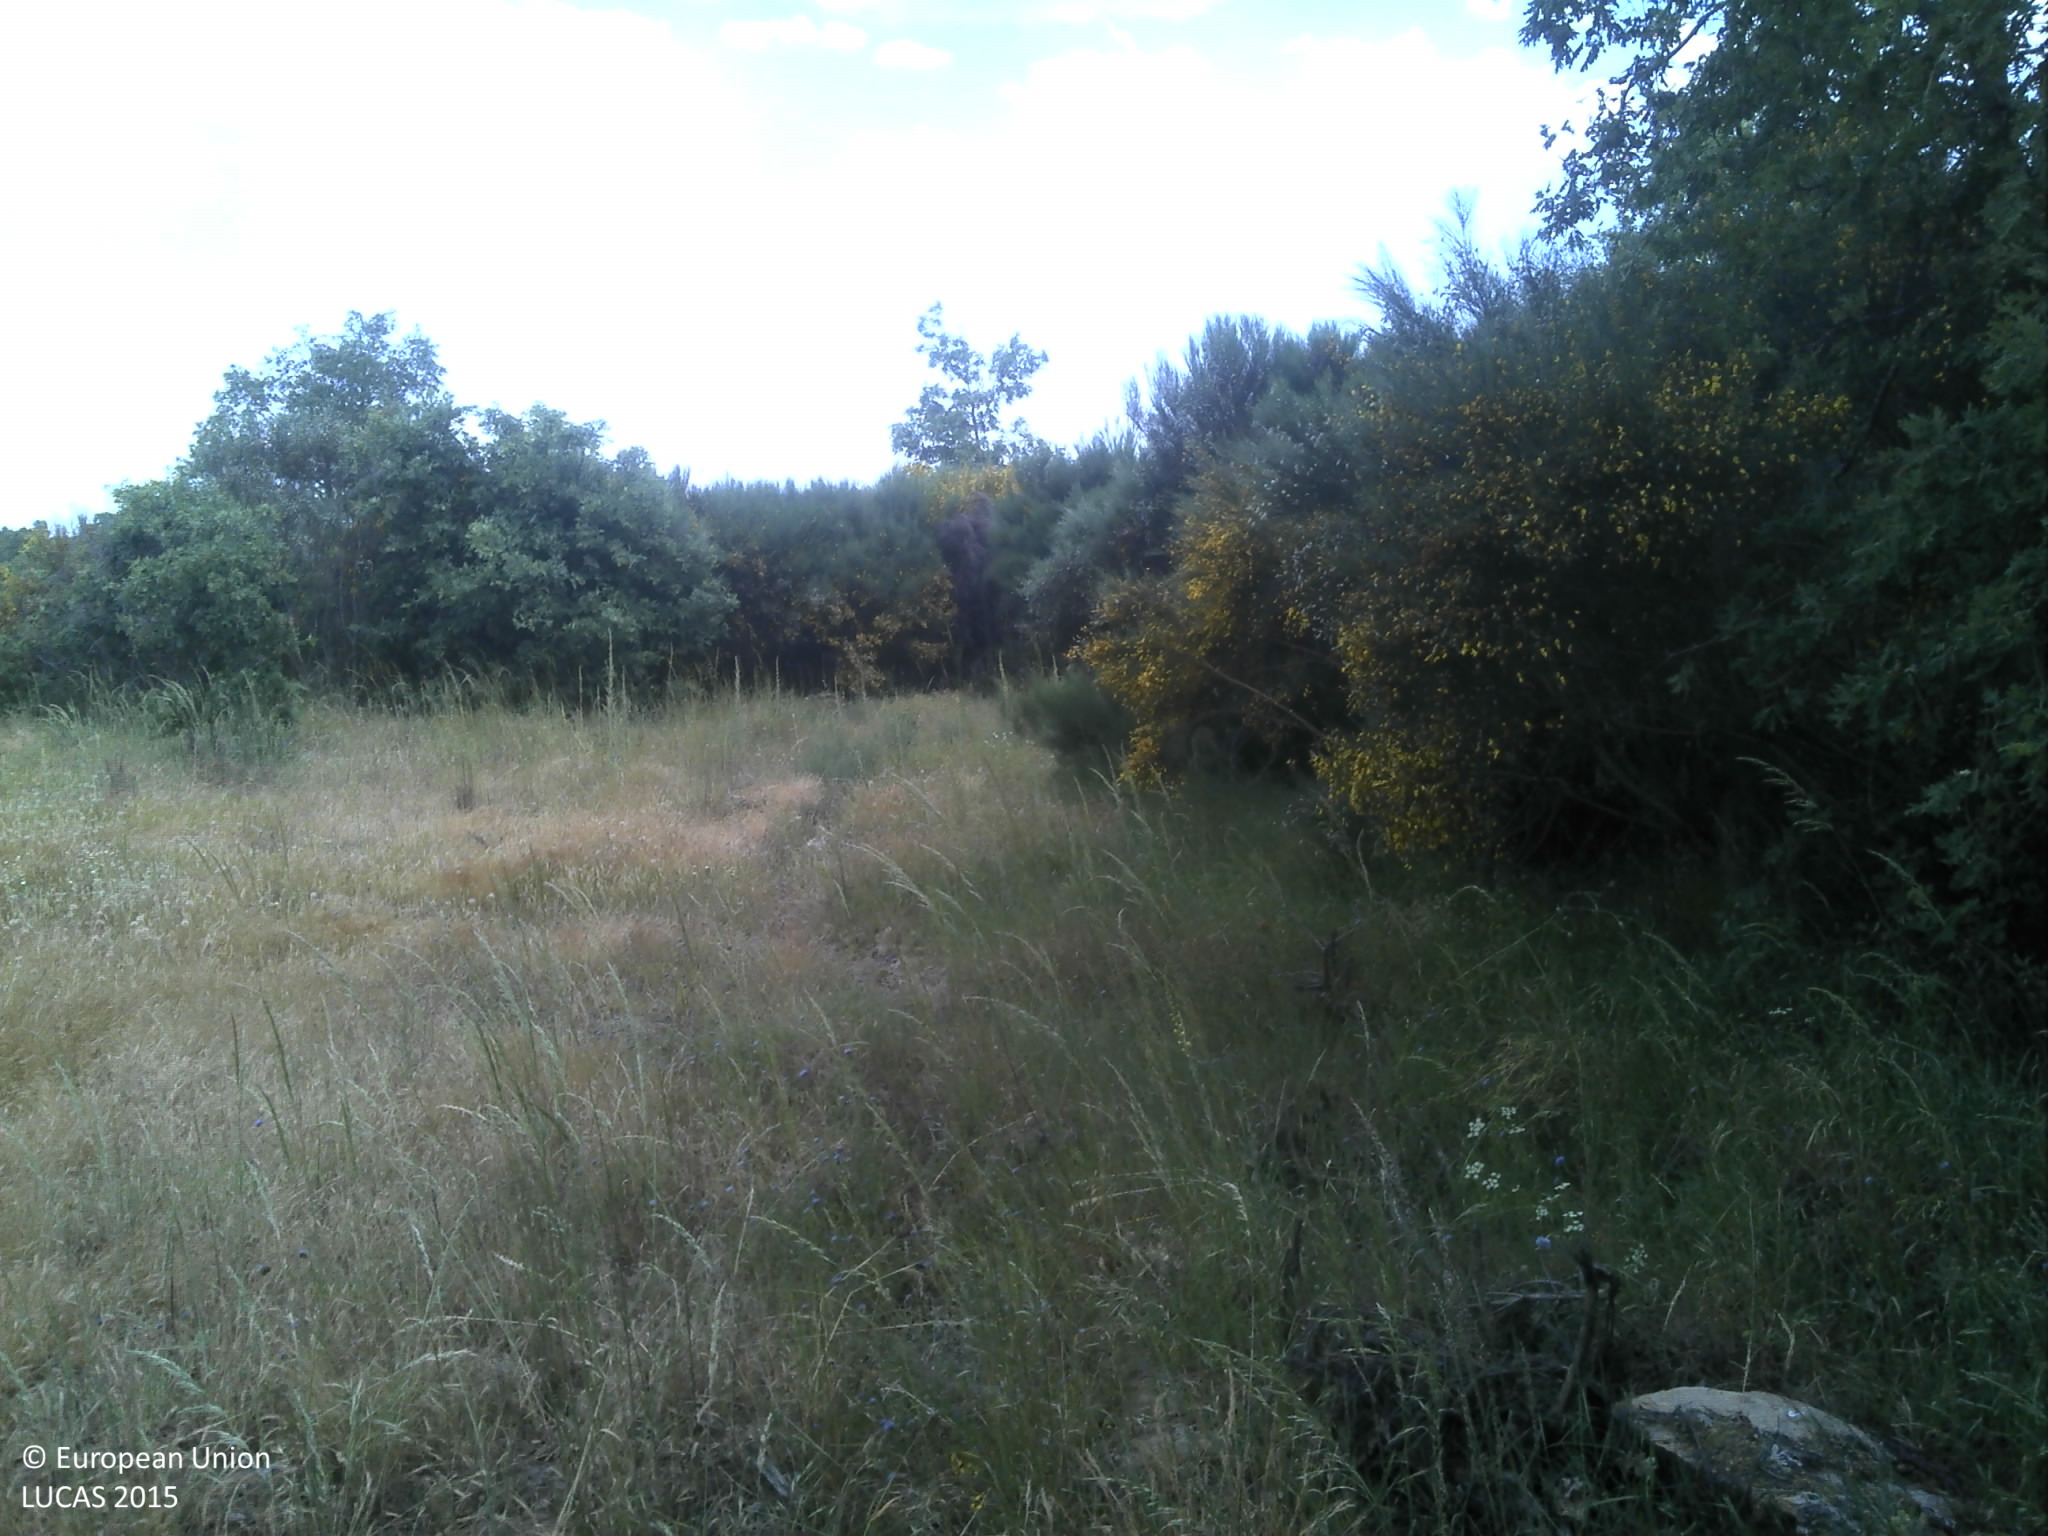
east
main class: Grassland
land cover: Grassland without tree/shrub cover
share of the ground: 50 - 75 %
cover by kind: herbaceous plants 75 %, unconsolidated bare surface 20 %, shrubs 5 %
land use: Agriculture (excluding fallow land and kitchen gardens)
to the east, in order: Grassland without tree/shrub cover; Shrubland without tree cover; Dry stone walls; Tracks; Dry stone walls; Grassland without tree/shrub cover; Dry stone walls; Grassland without tree/shrub cover; Dry stone walls; Tracks; Shrubland without tree cover; Grassland without tree/shrub cover; Rocks and stones; Grassland without tree/shrub cover
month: June
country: PT
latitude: 40.5002
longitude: -7.1290
